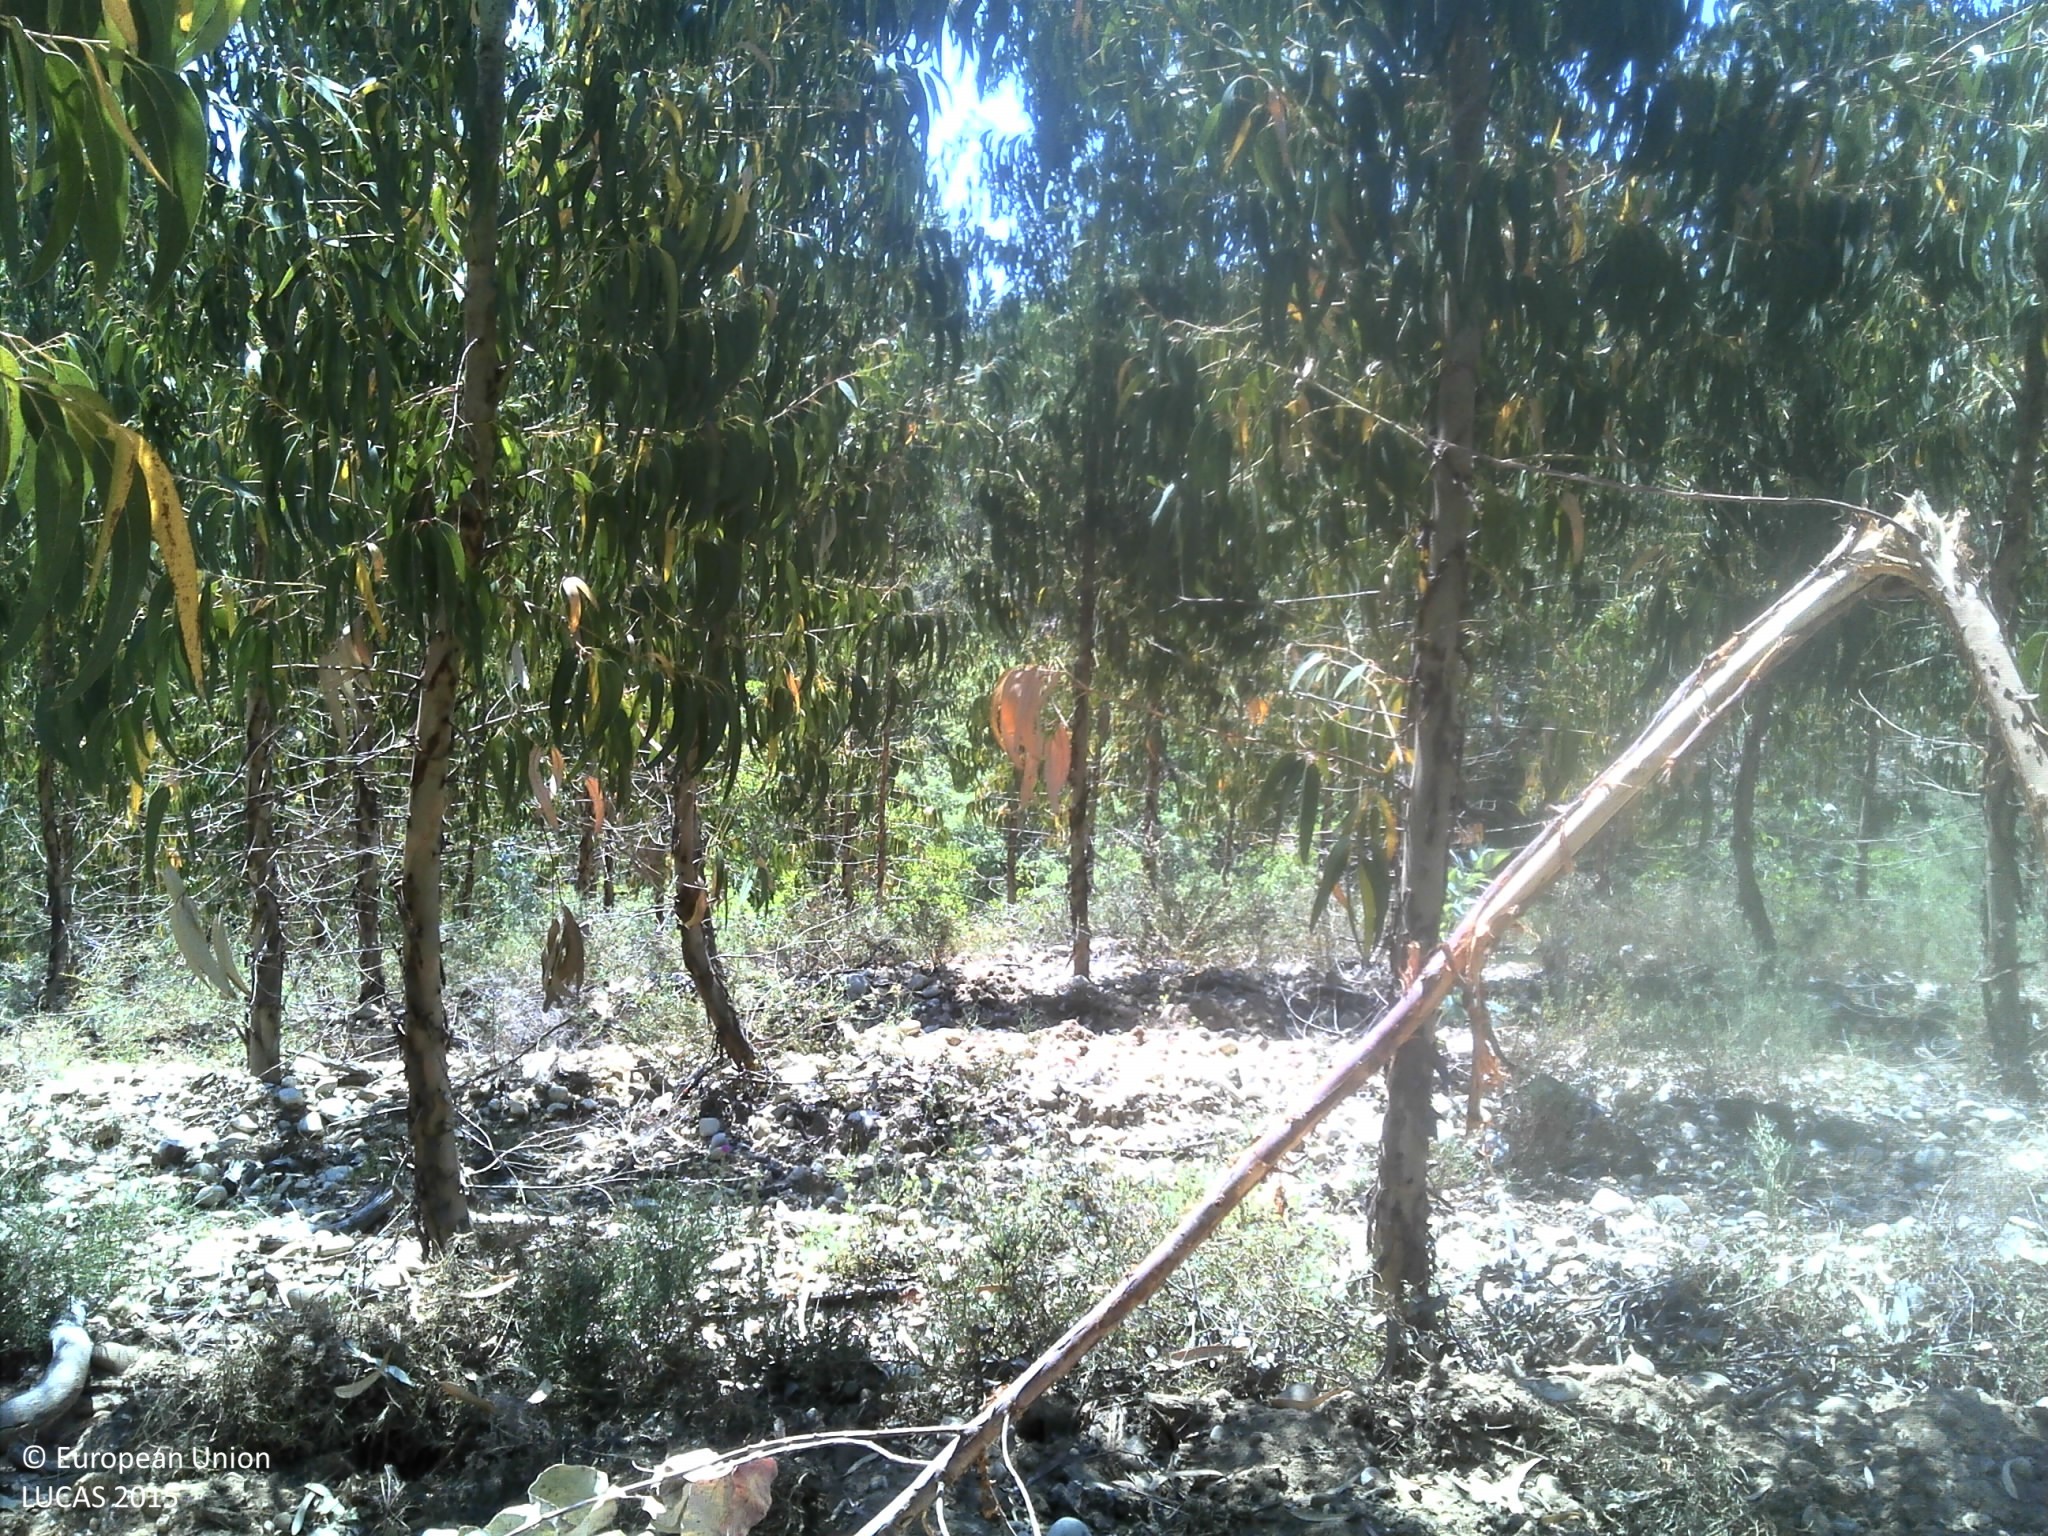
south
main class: Woodland
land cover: Broadleaved woodland
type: exotic forest
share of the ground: 25 - 50 %
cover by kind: broadleaved forest trees 60 %, shrubs 20 %, herbaceous plants 20 %
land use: Forestry
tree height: > 5 m
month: May
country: PT
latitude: 39.3622
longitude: -8.2976
